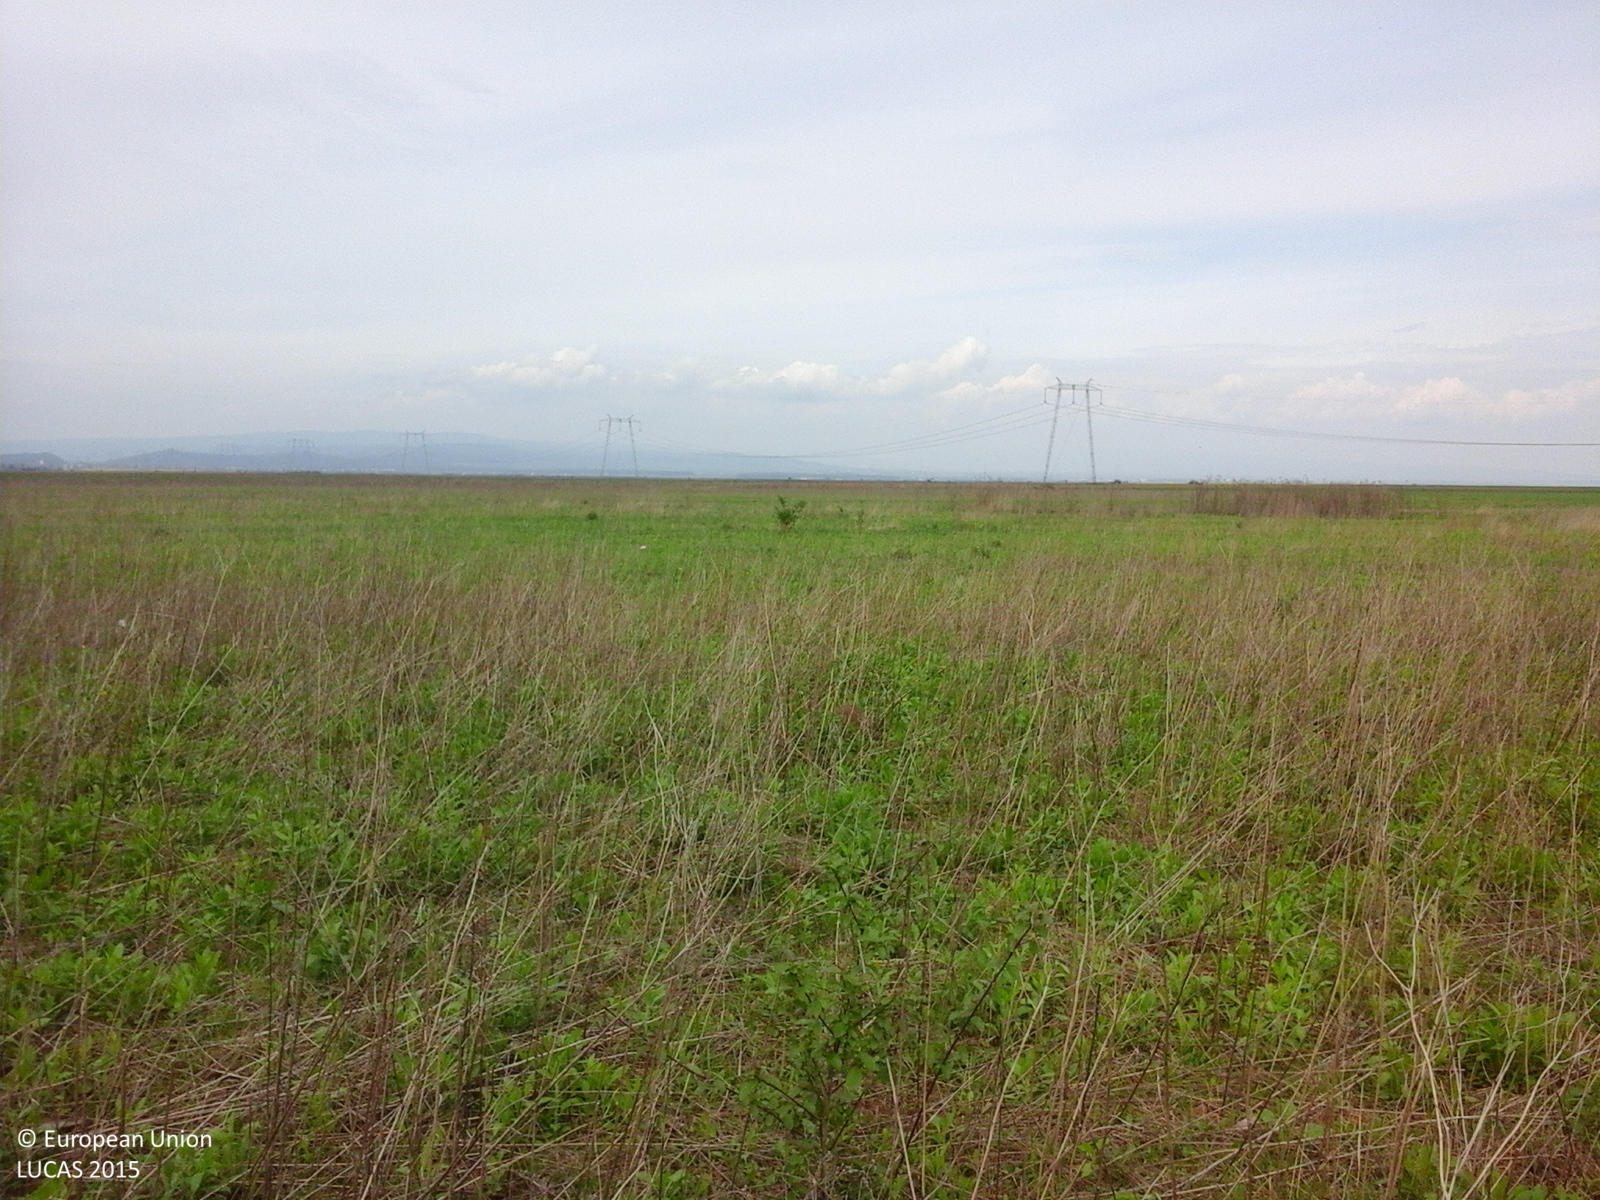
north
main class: Grassland
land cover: Grassland without tree/shrub cover
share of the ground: > 75 %
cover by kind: herbaceous plants 100 %
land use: Agriculture (excluding fallow land and kitchen gardens)
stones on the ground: 10 - 25 %
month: May
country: RO
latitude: 45.6380
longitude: 25.7201
